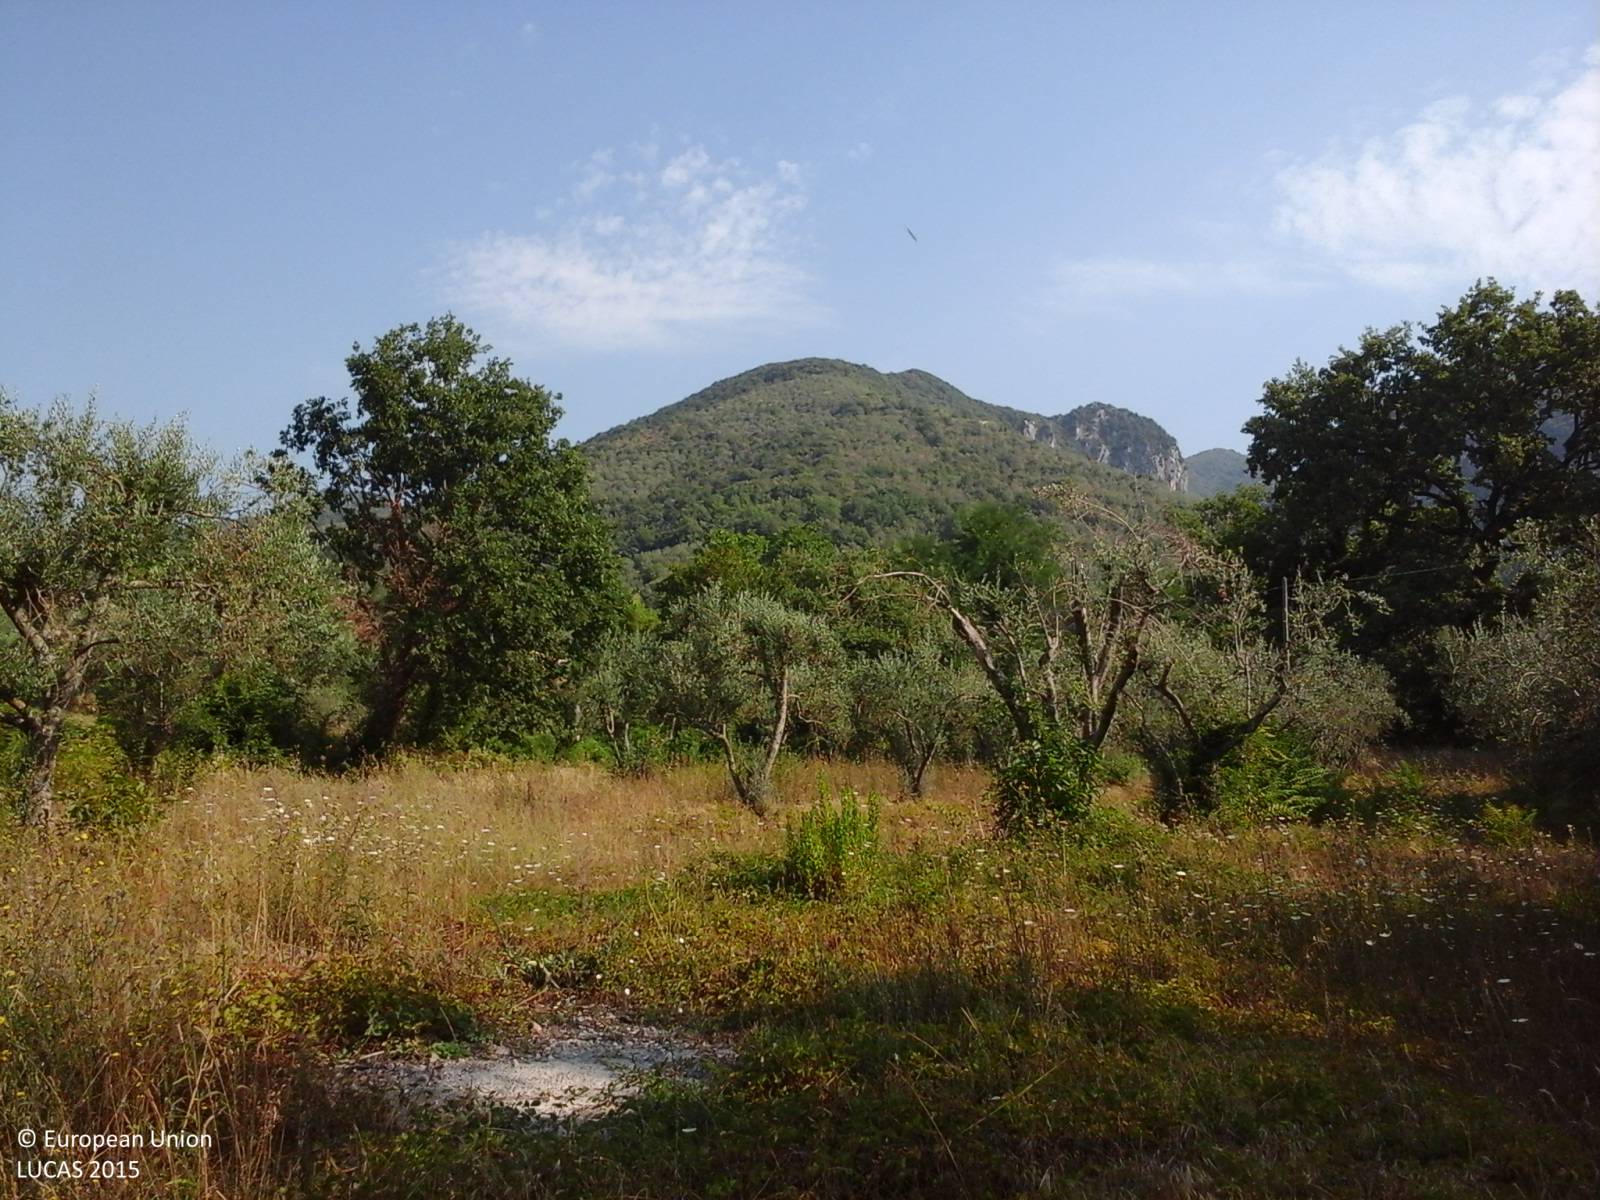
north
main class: Cropland
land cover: Olive groves
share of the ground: 50 - 75 %
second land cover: Spontaneously vegetated surfaces
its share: > 75 %
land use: Agriculture (excluding fallow land and kitchen gardens)
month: August
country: IT
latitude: 41.3516
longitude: 14.2747
